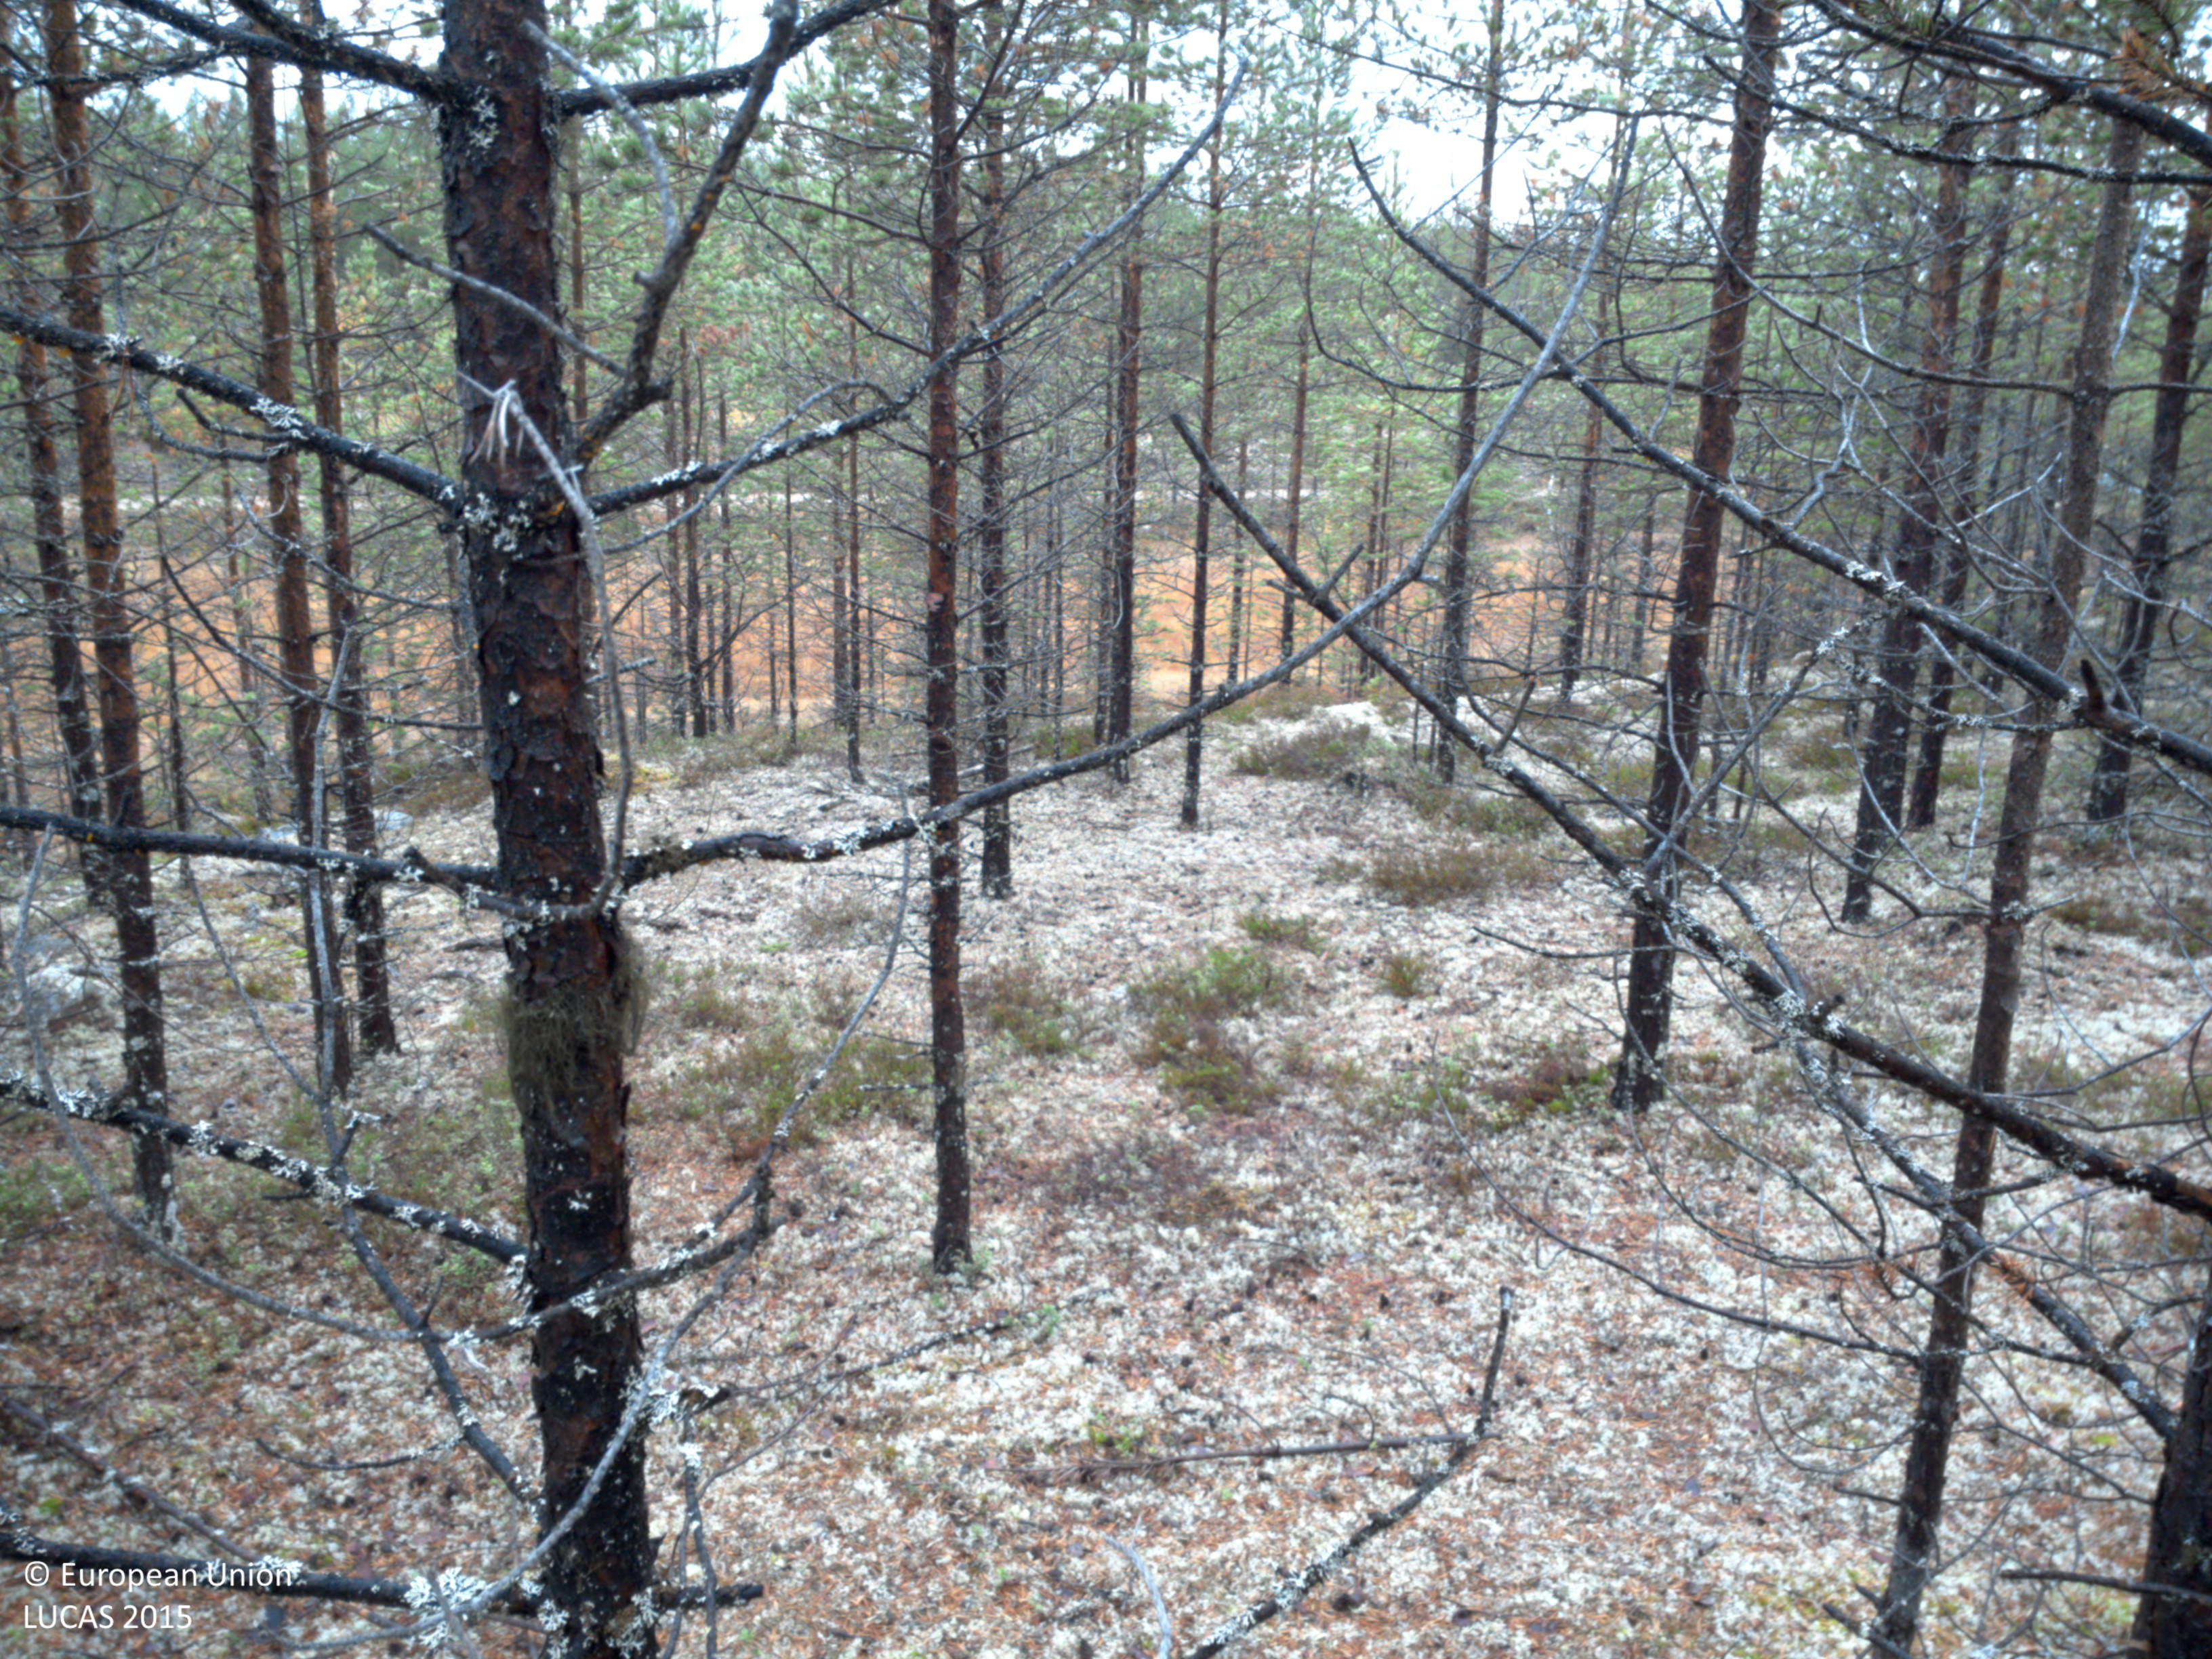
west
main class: Woodland
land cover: Pine dominated coniferous woodland
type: boreal forest
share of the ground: > 75 %
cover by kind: coniferous forest trees 80 %, shrubs 10 %, lichens and mosses 10 %
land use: Forestry
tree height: > 5 m
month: September
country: SE
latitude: 64.7323
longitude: 19.1860
